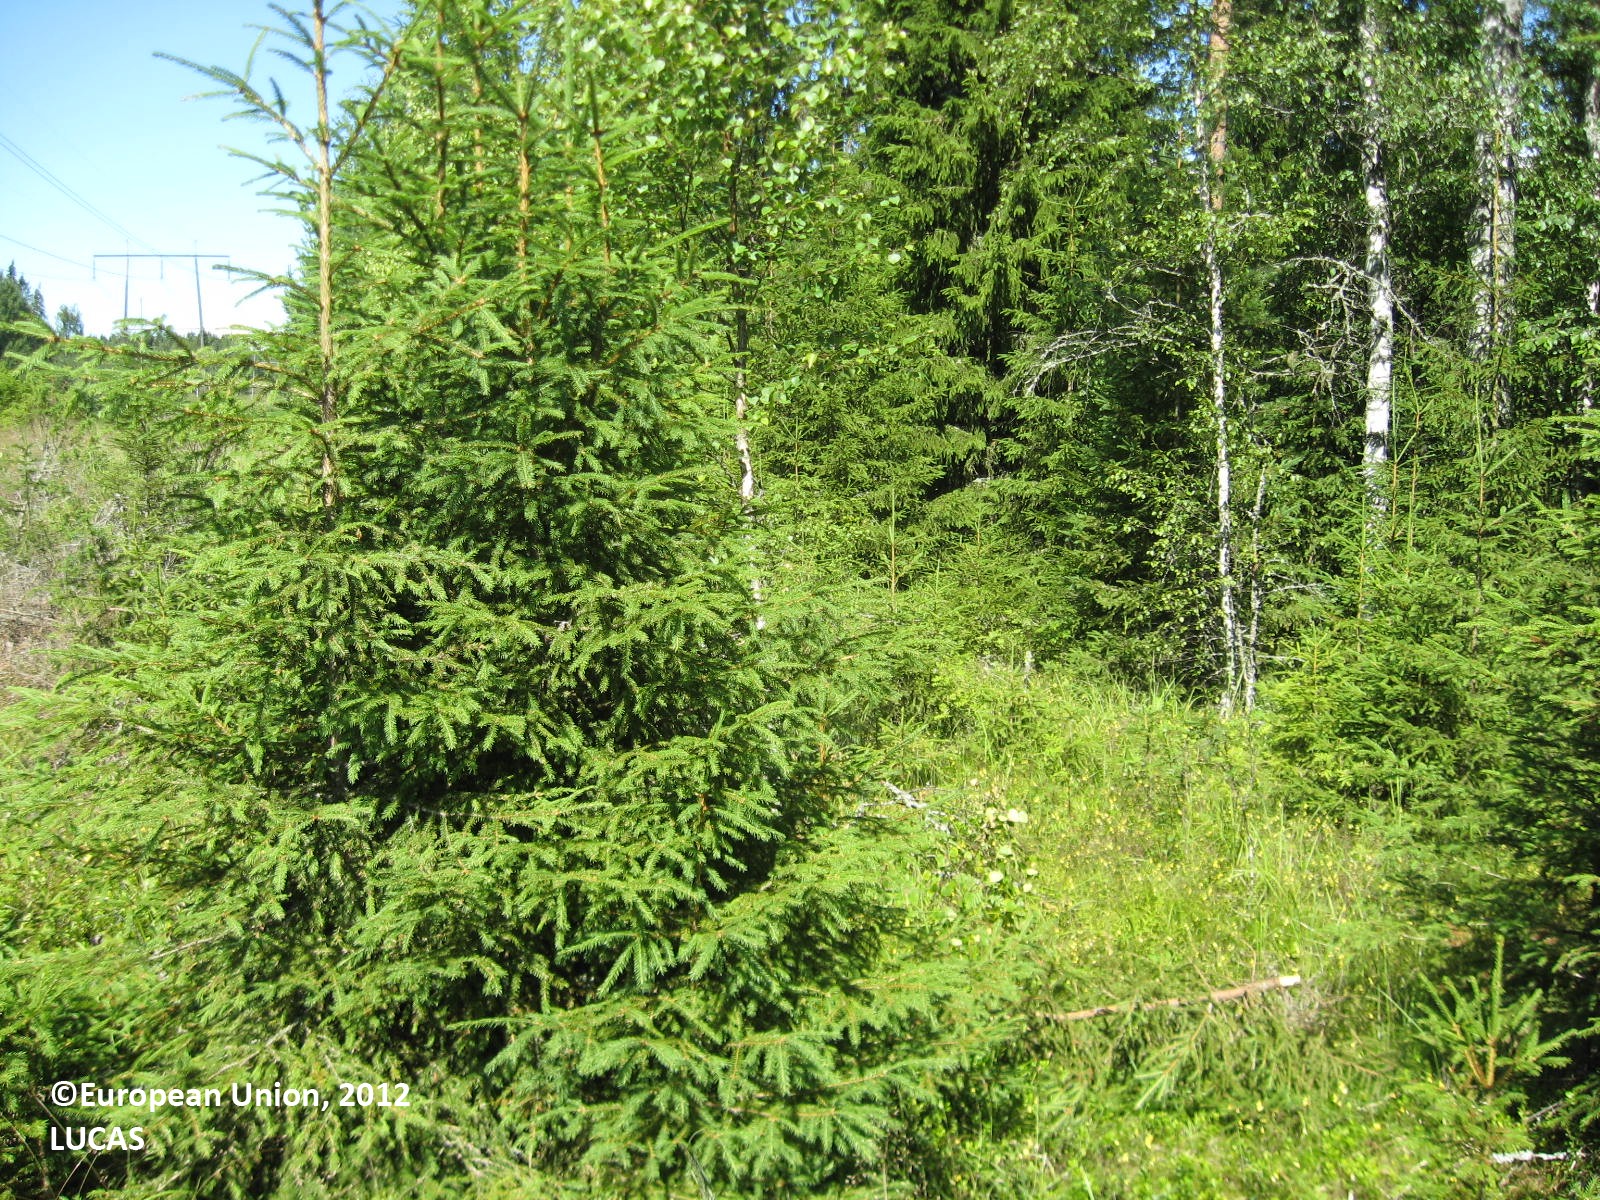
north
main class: Woodland
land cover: Spruce dominated mixed woodland
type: boreal forest
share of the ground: 50 - 75 %
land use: Energy production
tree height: > 5 m
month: July
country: FI
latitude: 62.1578
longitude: 21.6595
